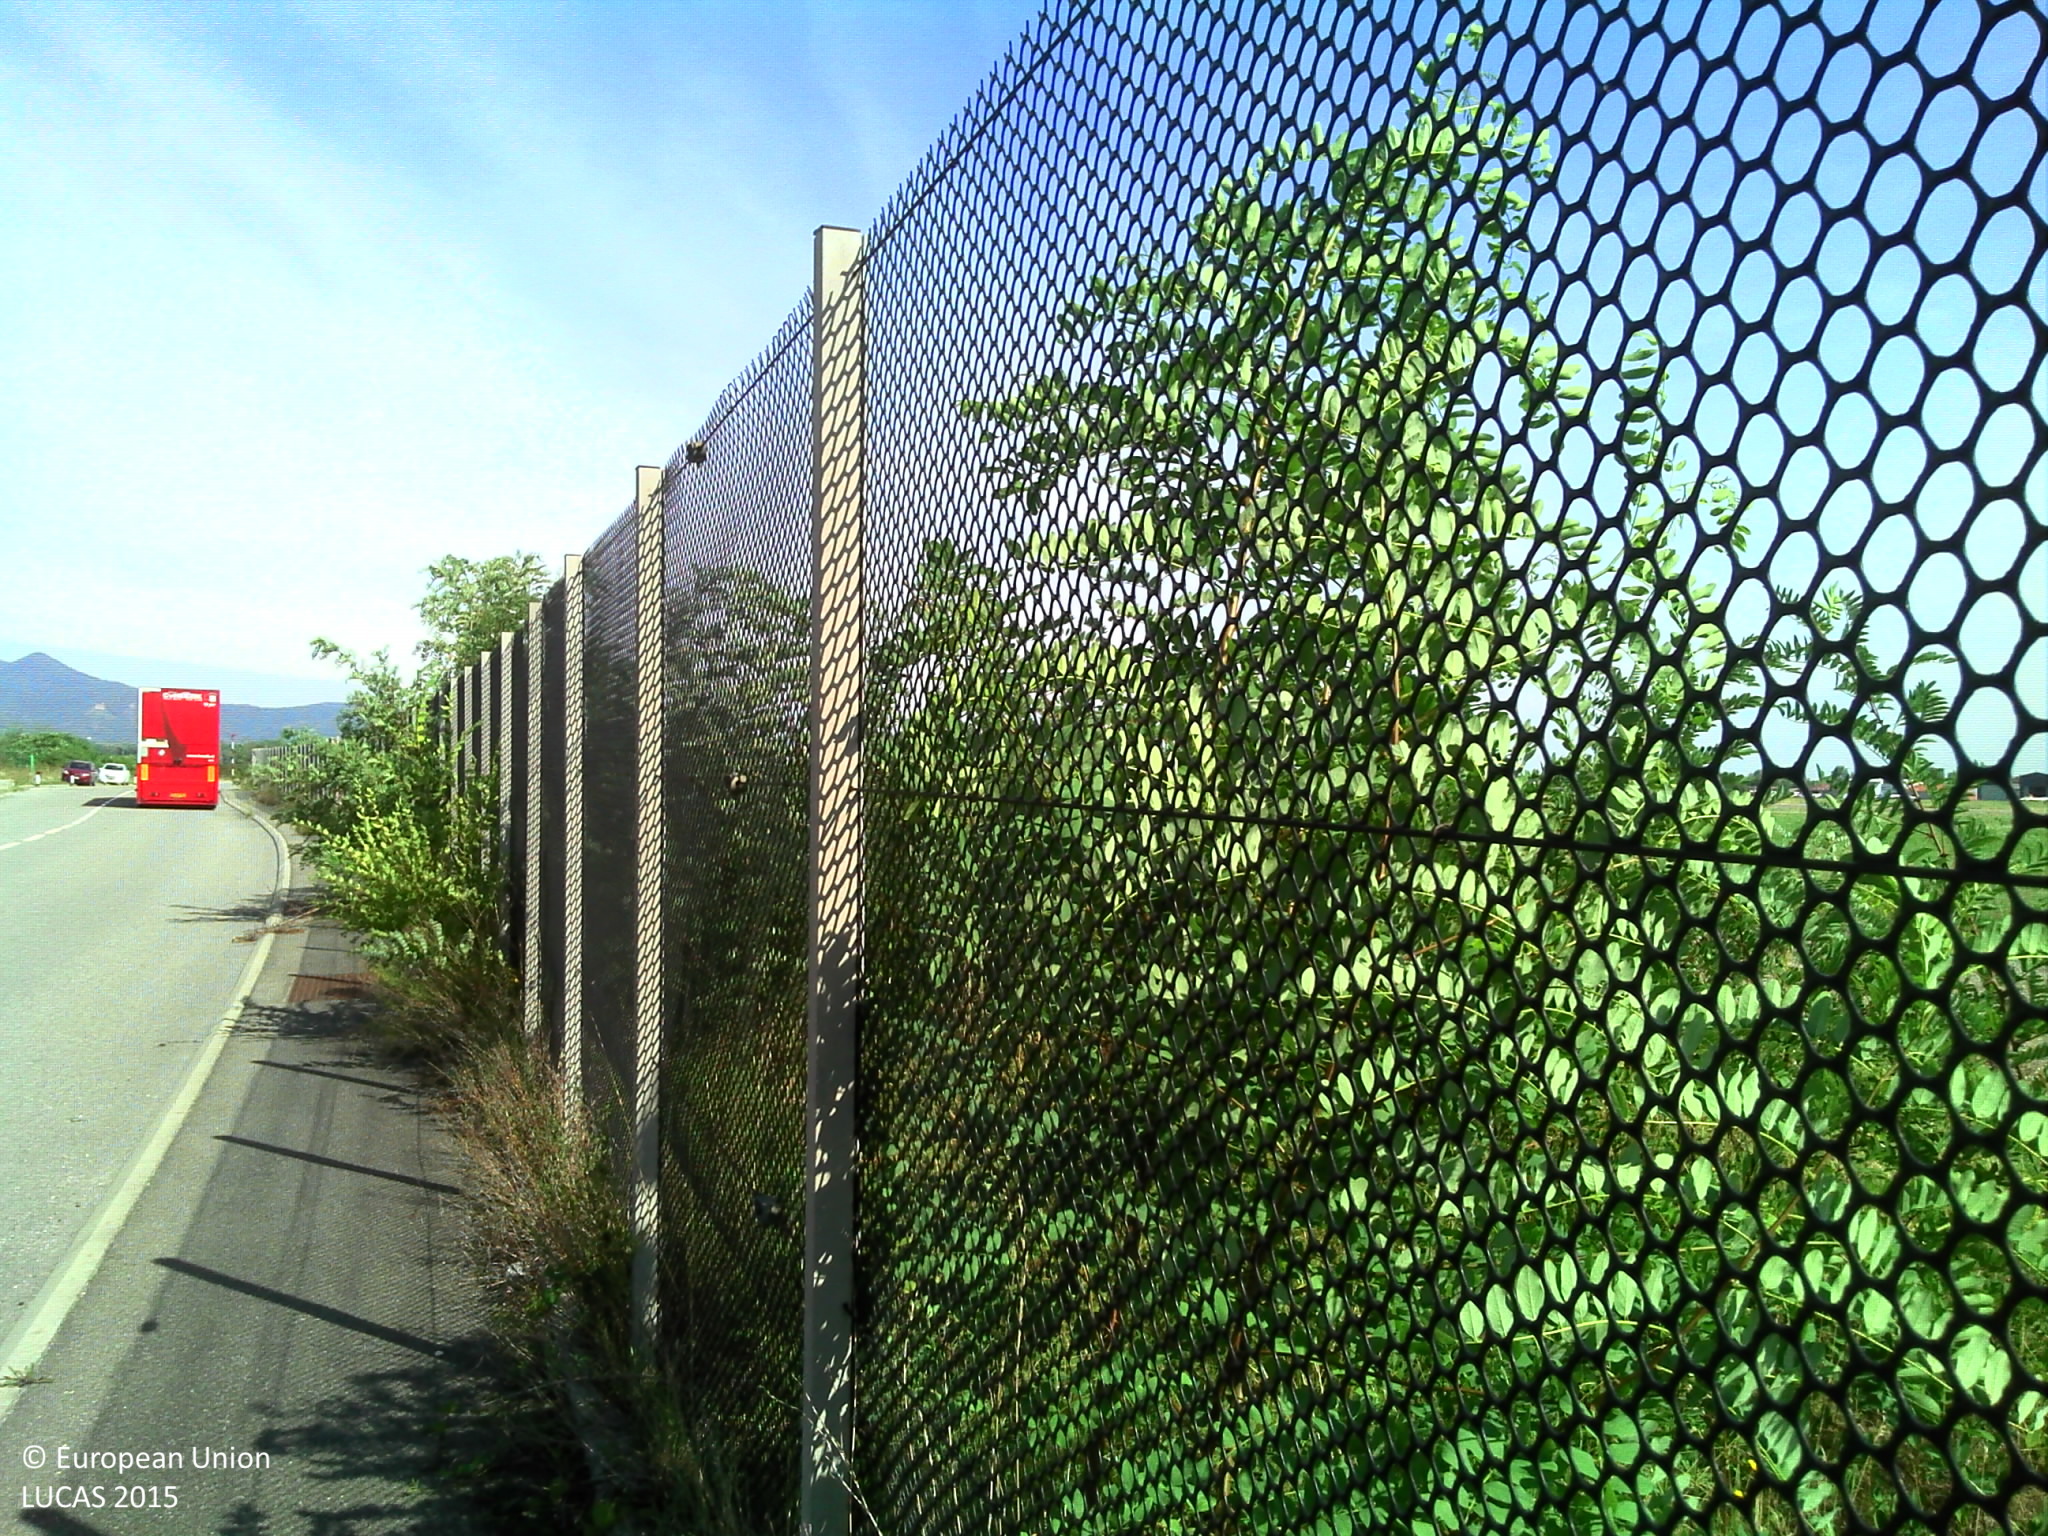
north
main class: Grassland
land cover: Grassland without tree/shrub cover
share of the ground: > 75 %
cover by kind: herbaceous plants 100 %
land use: Air transport
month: August
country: FR
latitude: 48.1018
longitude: 7.3556
